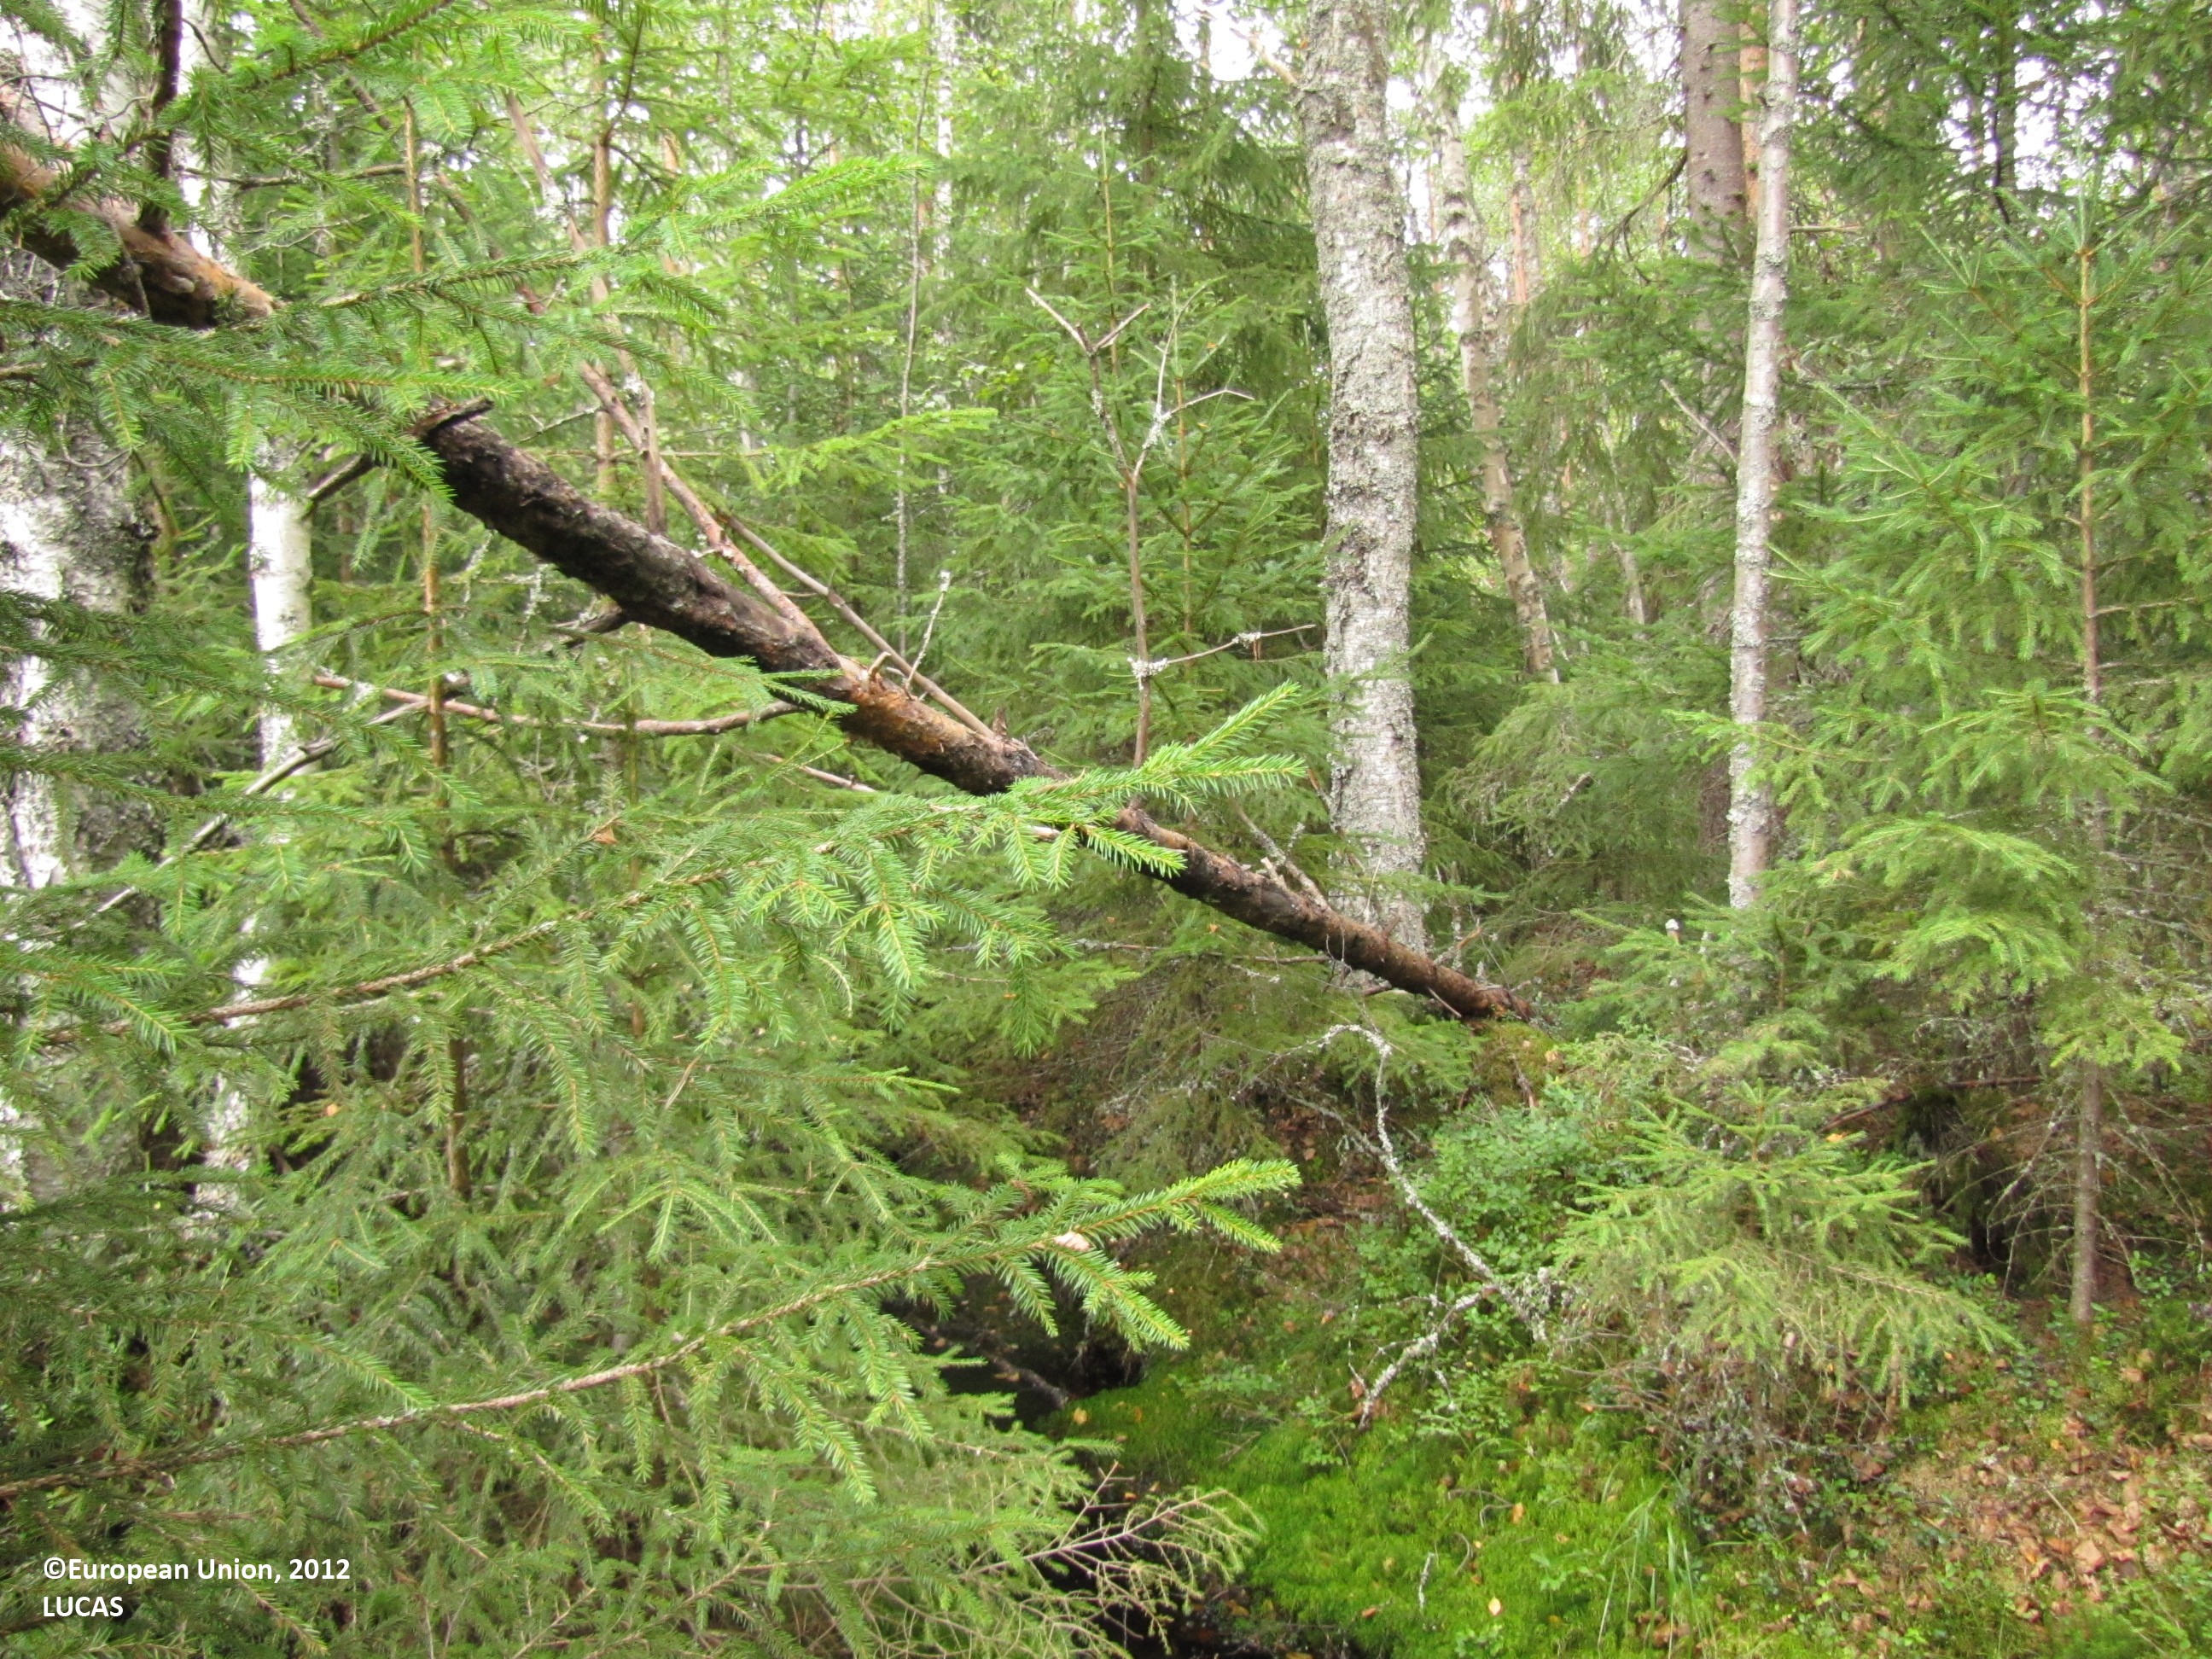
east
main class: Woodland
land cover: Pine dominated mixed woodland
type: boreal forest
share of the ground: 50 - 75 %
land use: Forestry
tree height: > 5 m
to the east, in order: Pine dominated mixed woodland; Ditches and canals; Pine dominated mixed woodland; Other coniferous woodland; Ditches and canals; Grass margins; Tracks; Grass margins; Ditches and canals; Pine dominated mixed woodland; Ditches and canals; Pine dominated mixed woodland; Other coniferous woodland; Ditches and canals; Pine dominated coniferous woodland; Ditches and canals; Pine dominated mixed woodland; Ditches and canals
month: August
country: FI
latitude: 61.8978
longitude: 23.2213
